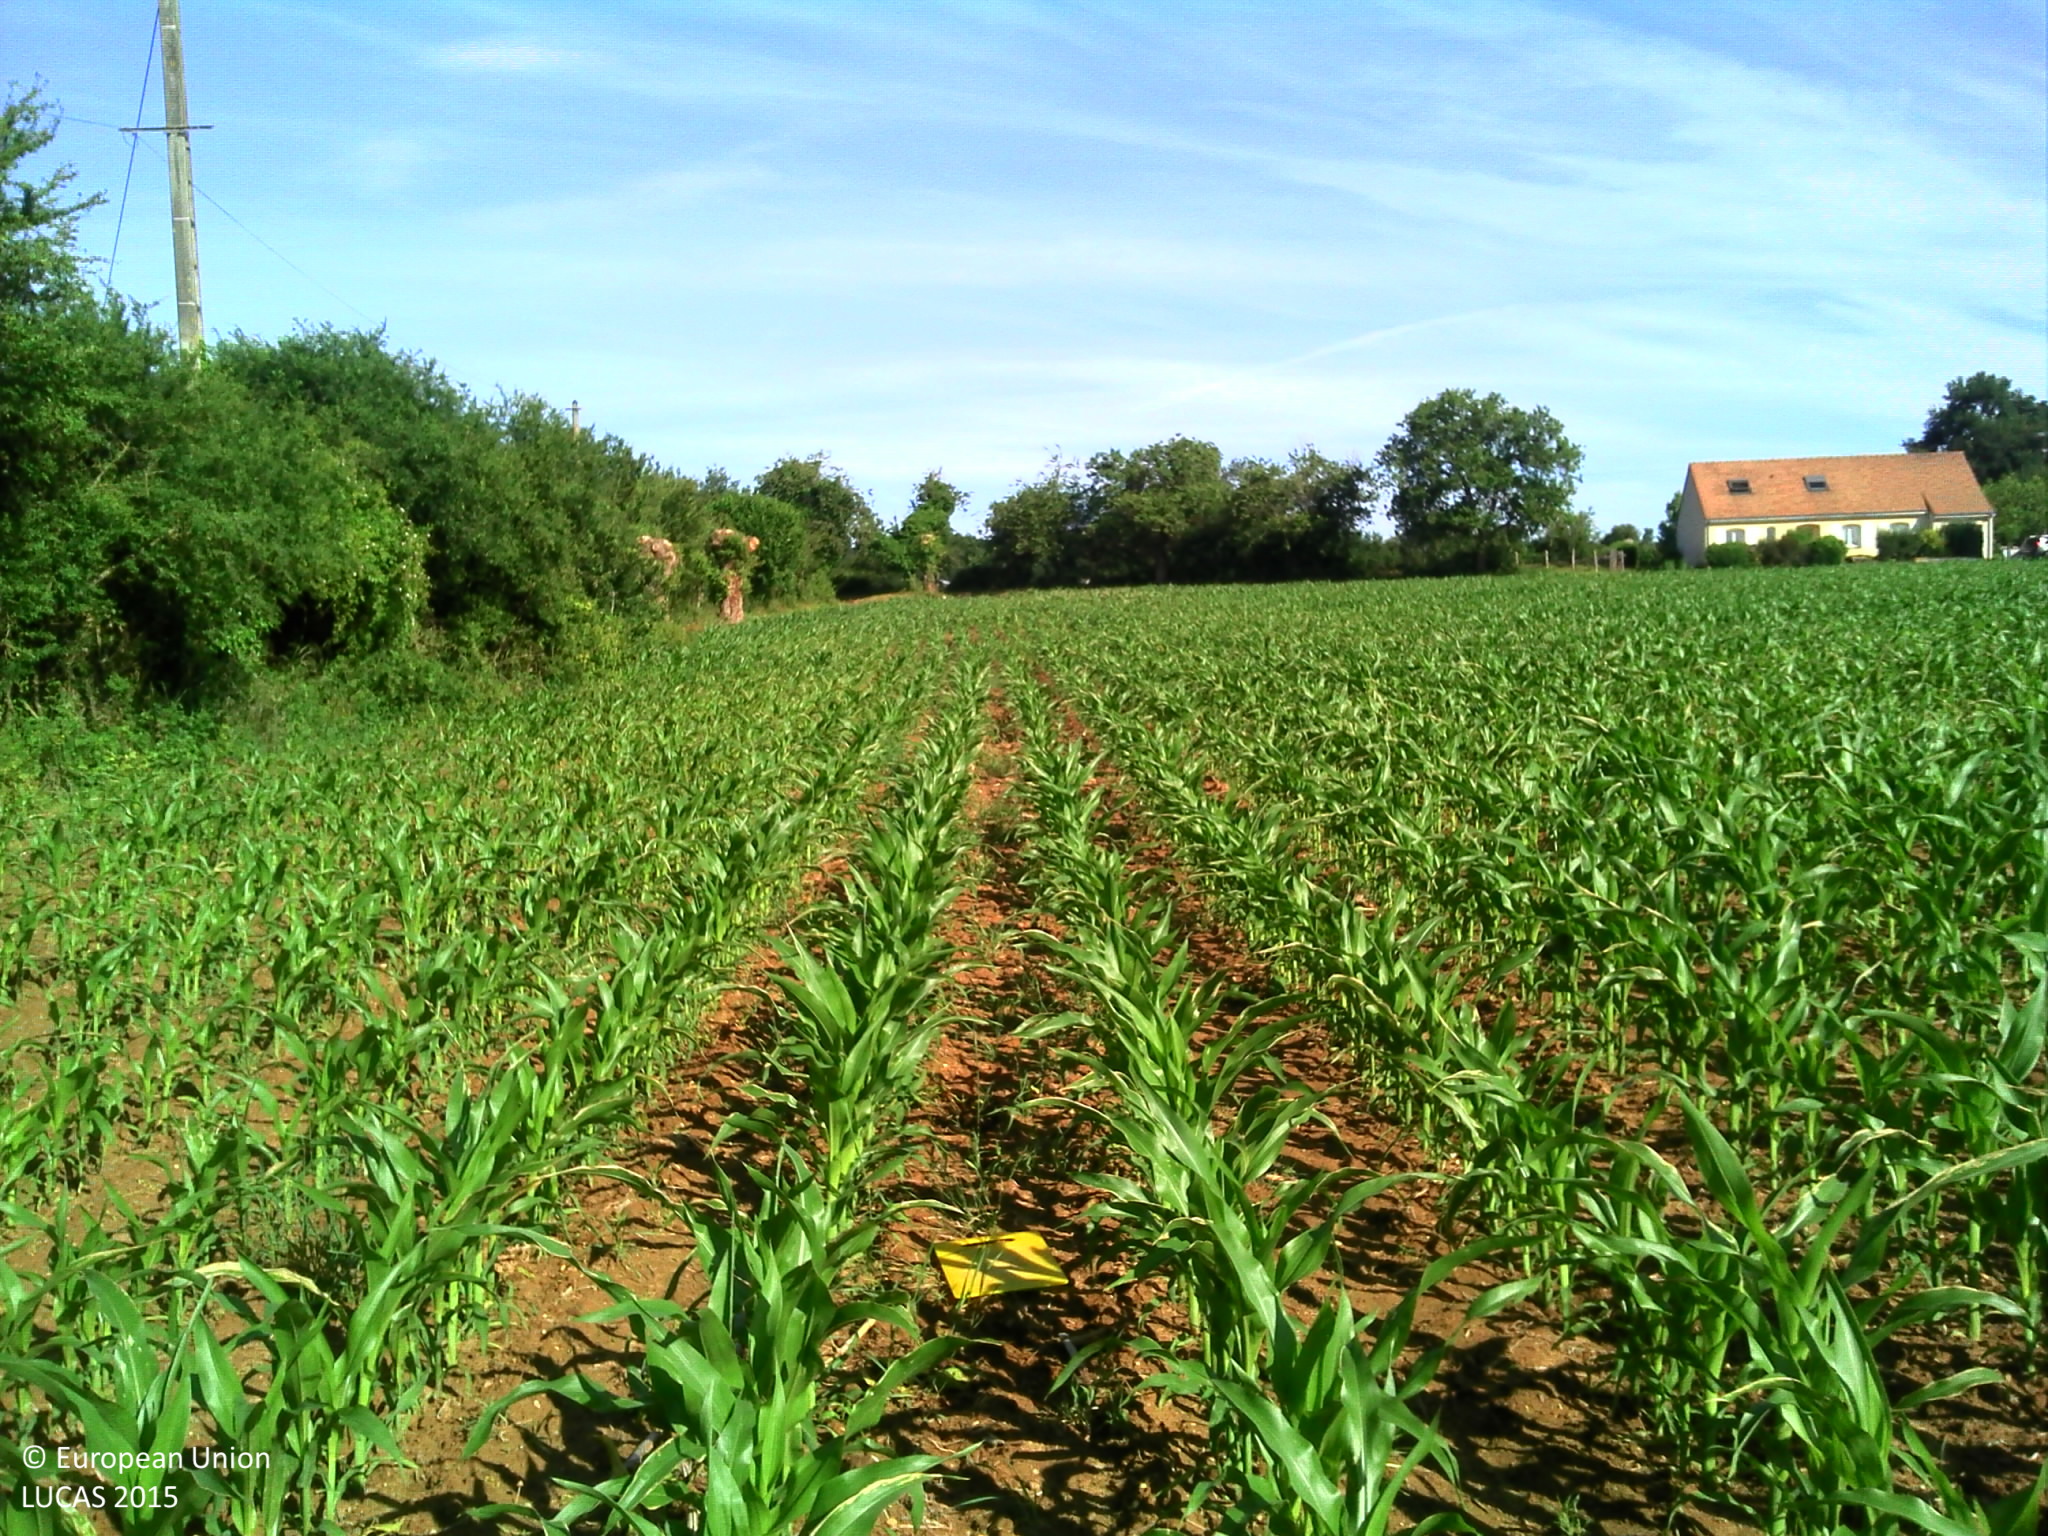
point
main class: Cropland
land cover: Maize
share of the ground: > 75 %
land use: Agriculture (excluding fallow land and kitchen gardens)
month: June
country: FR
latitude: 48.0286
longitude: 0.2792
